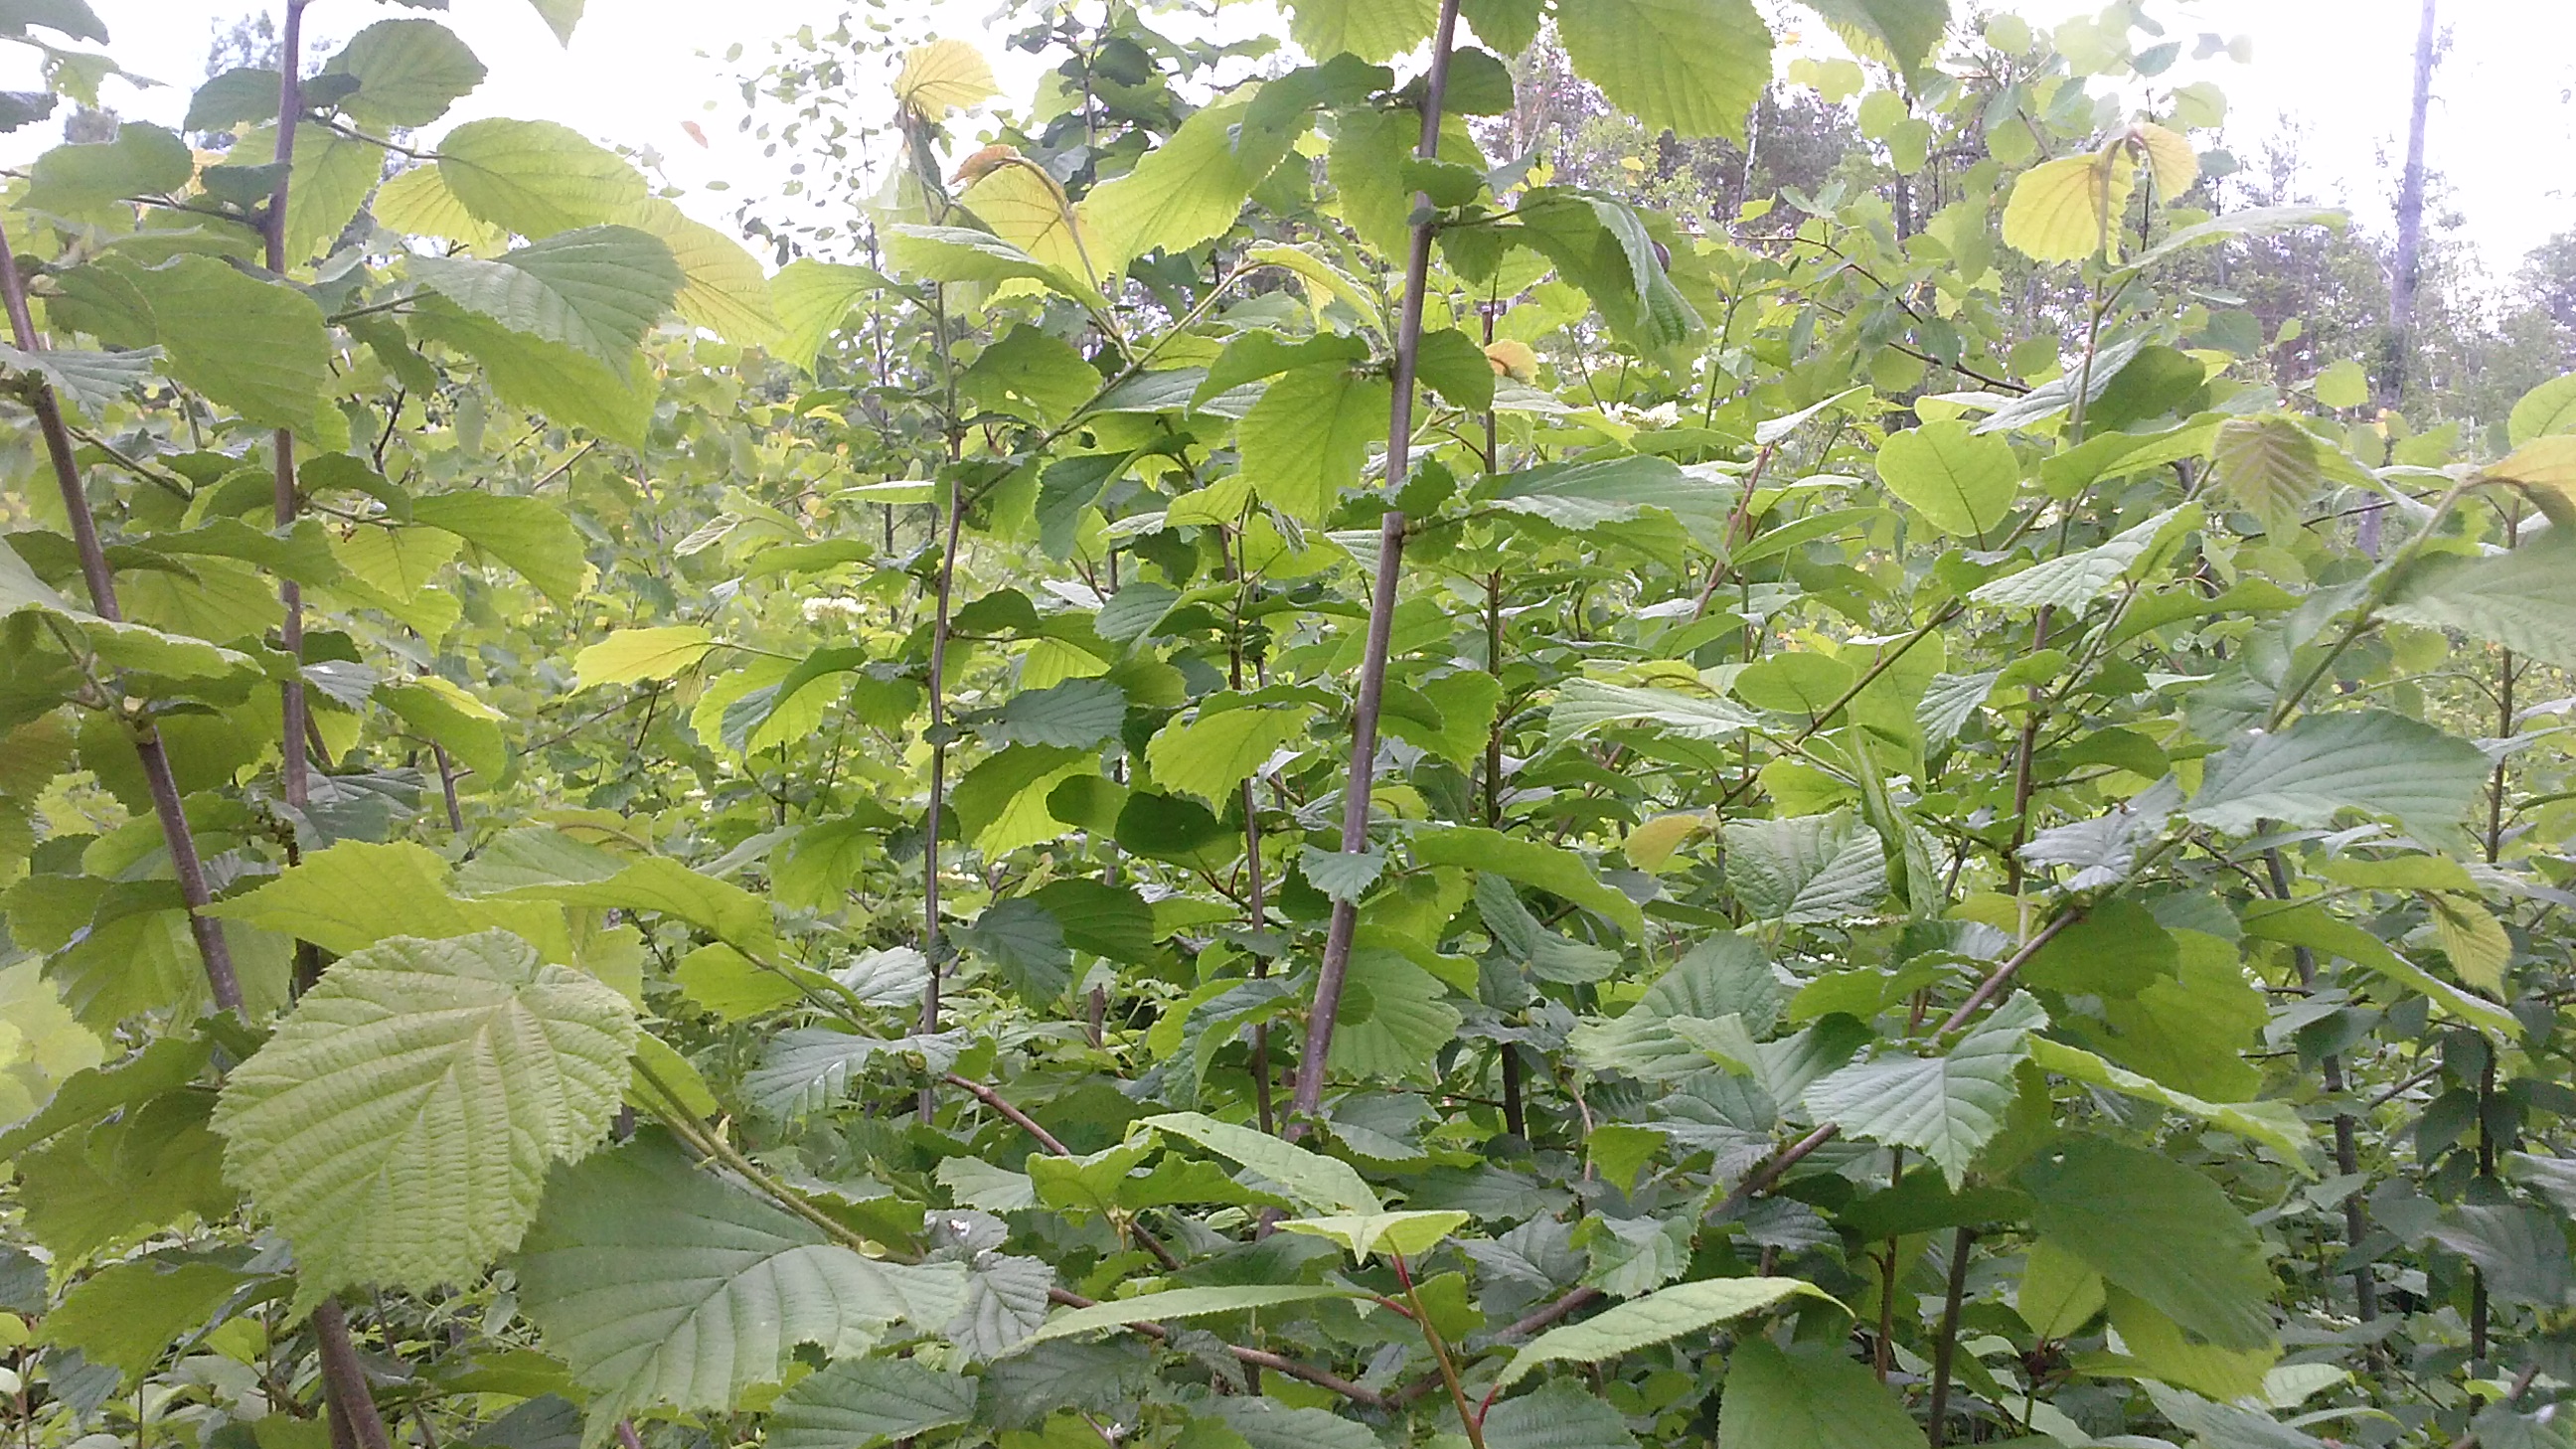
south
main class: Woodland
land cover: Broadleaved woodland
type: non-riverine alder, birch or aspen forest
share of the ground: 50 - 75 %
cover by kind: broadleaved forest trees 65 %, herbaceous plants 30 %, shrubs 5 %
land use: Forestry
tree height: < 5 m
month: June
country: LV
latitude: 56.3210
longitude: 28.1337
